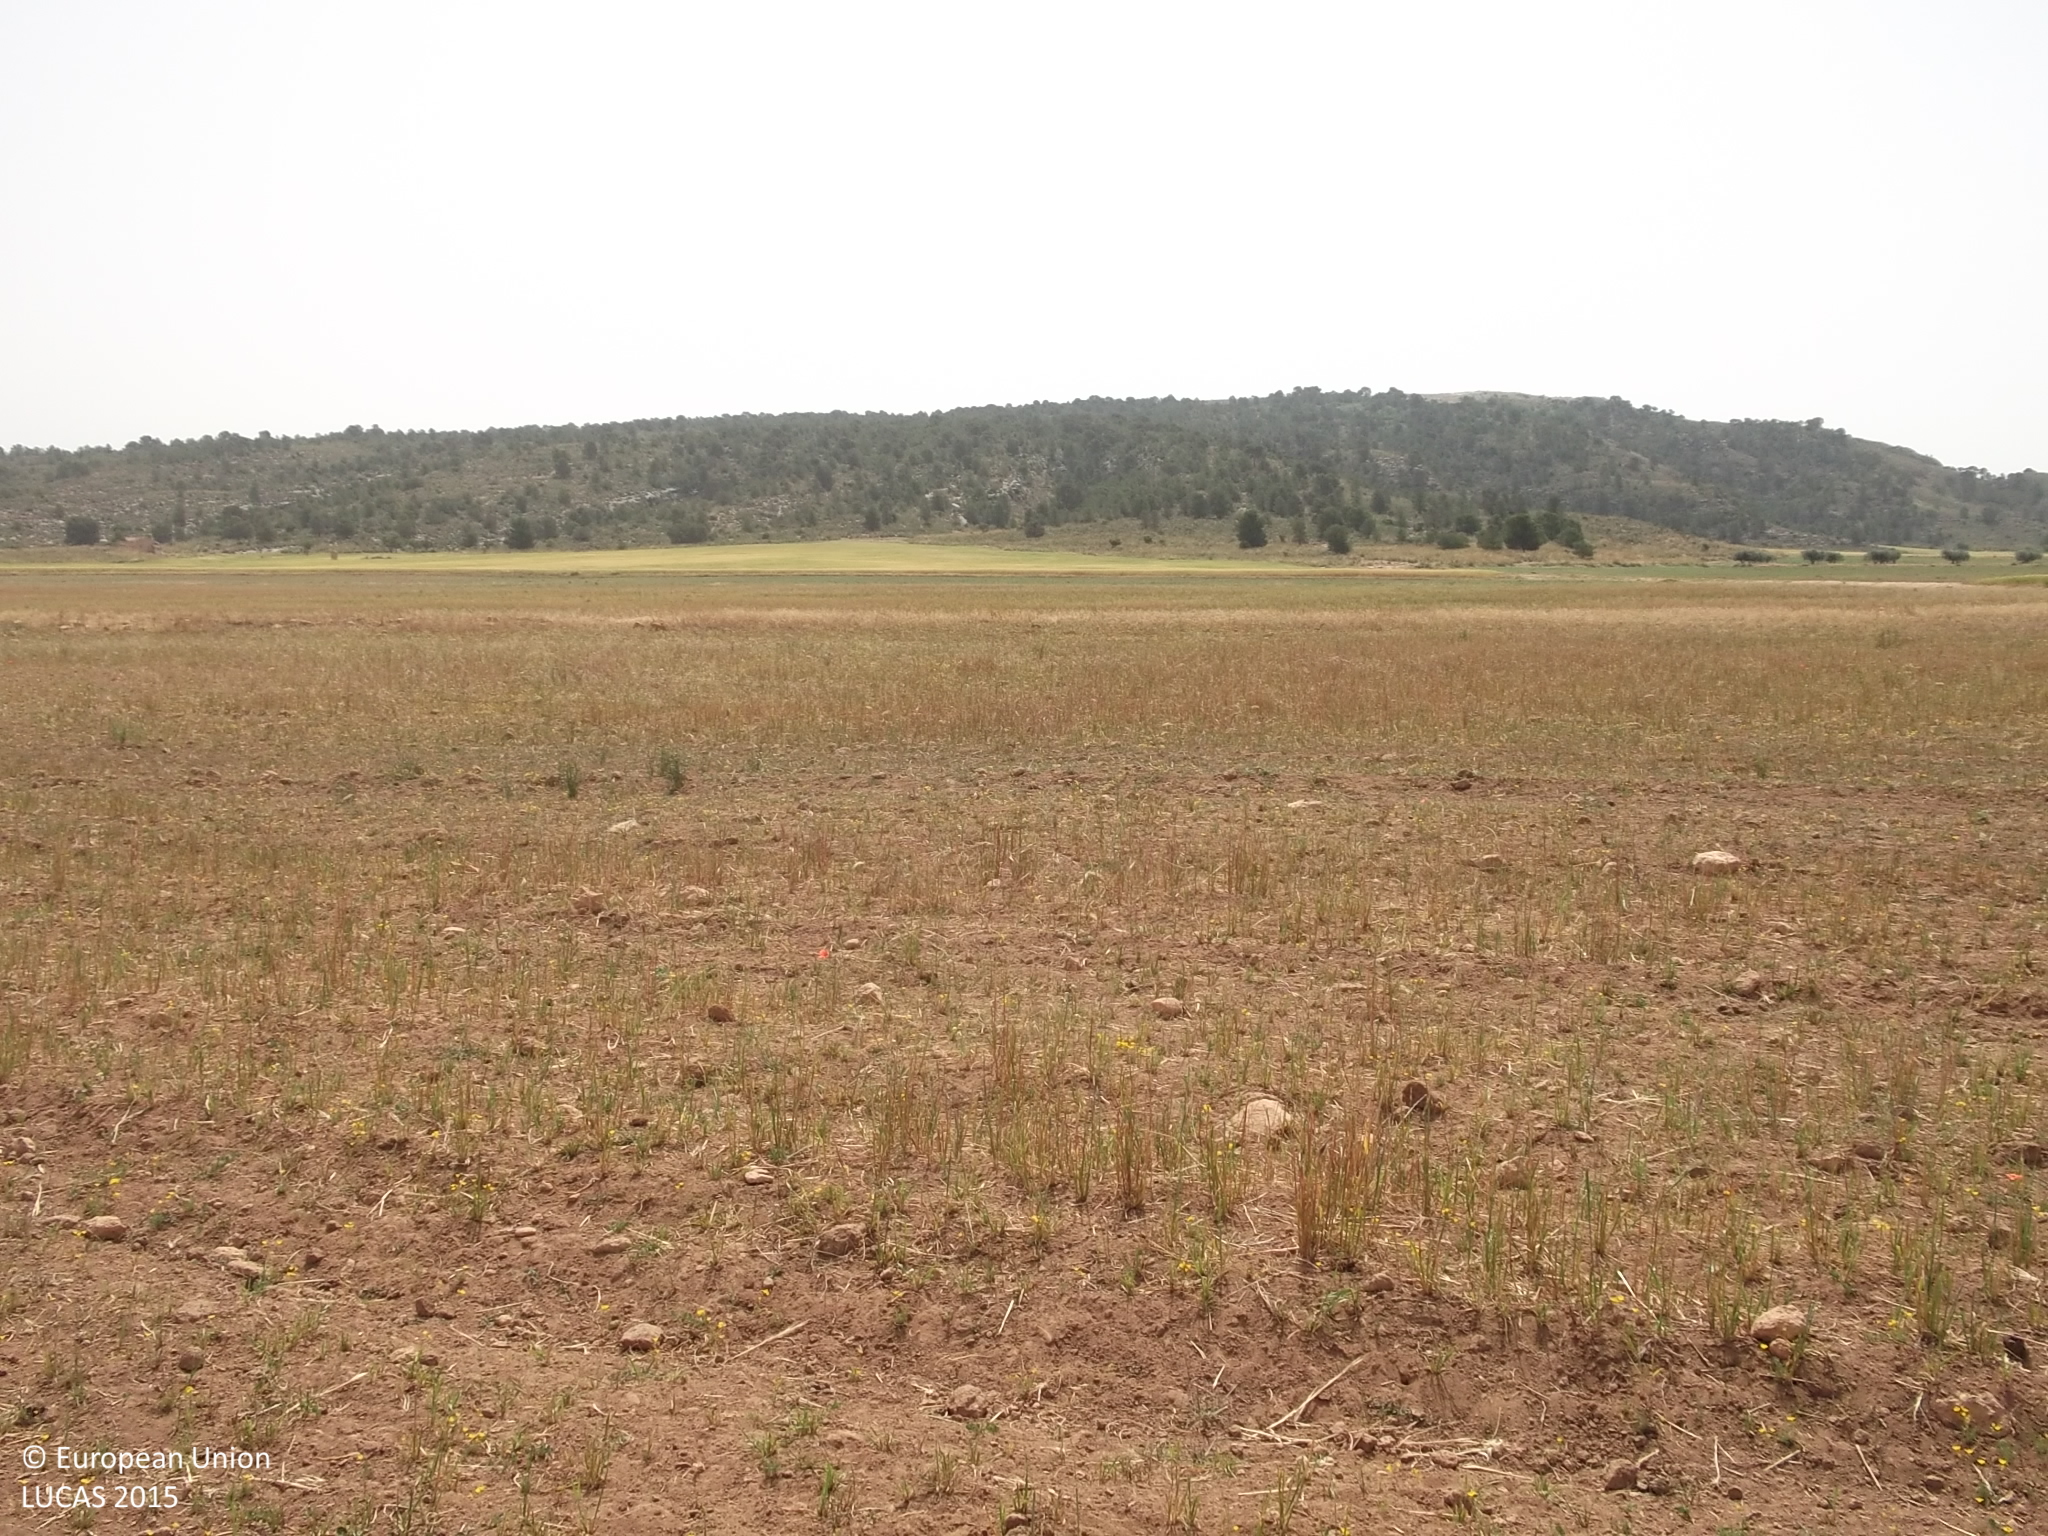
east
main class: Grassland
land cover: Spontaneously vegetated surfaces
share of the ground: 50 - 75 %
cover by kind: herbaceous plants 50 %, unconsolidated bare surface 50 %
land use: Fallow land
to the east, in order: Spontaneously vegetated surfaces; Grass margins; Spontaneously vegetated surfaces
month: May
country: ES
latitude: 38.4564
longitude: -1.6466
